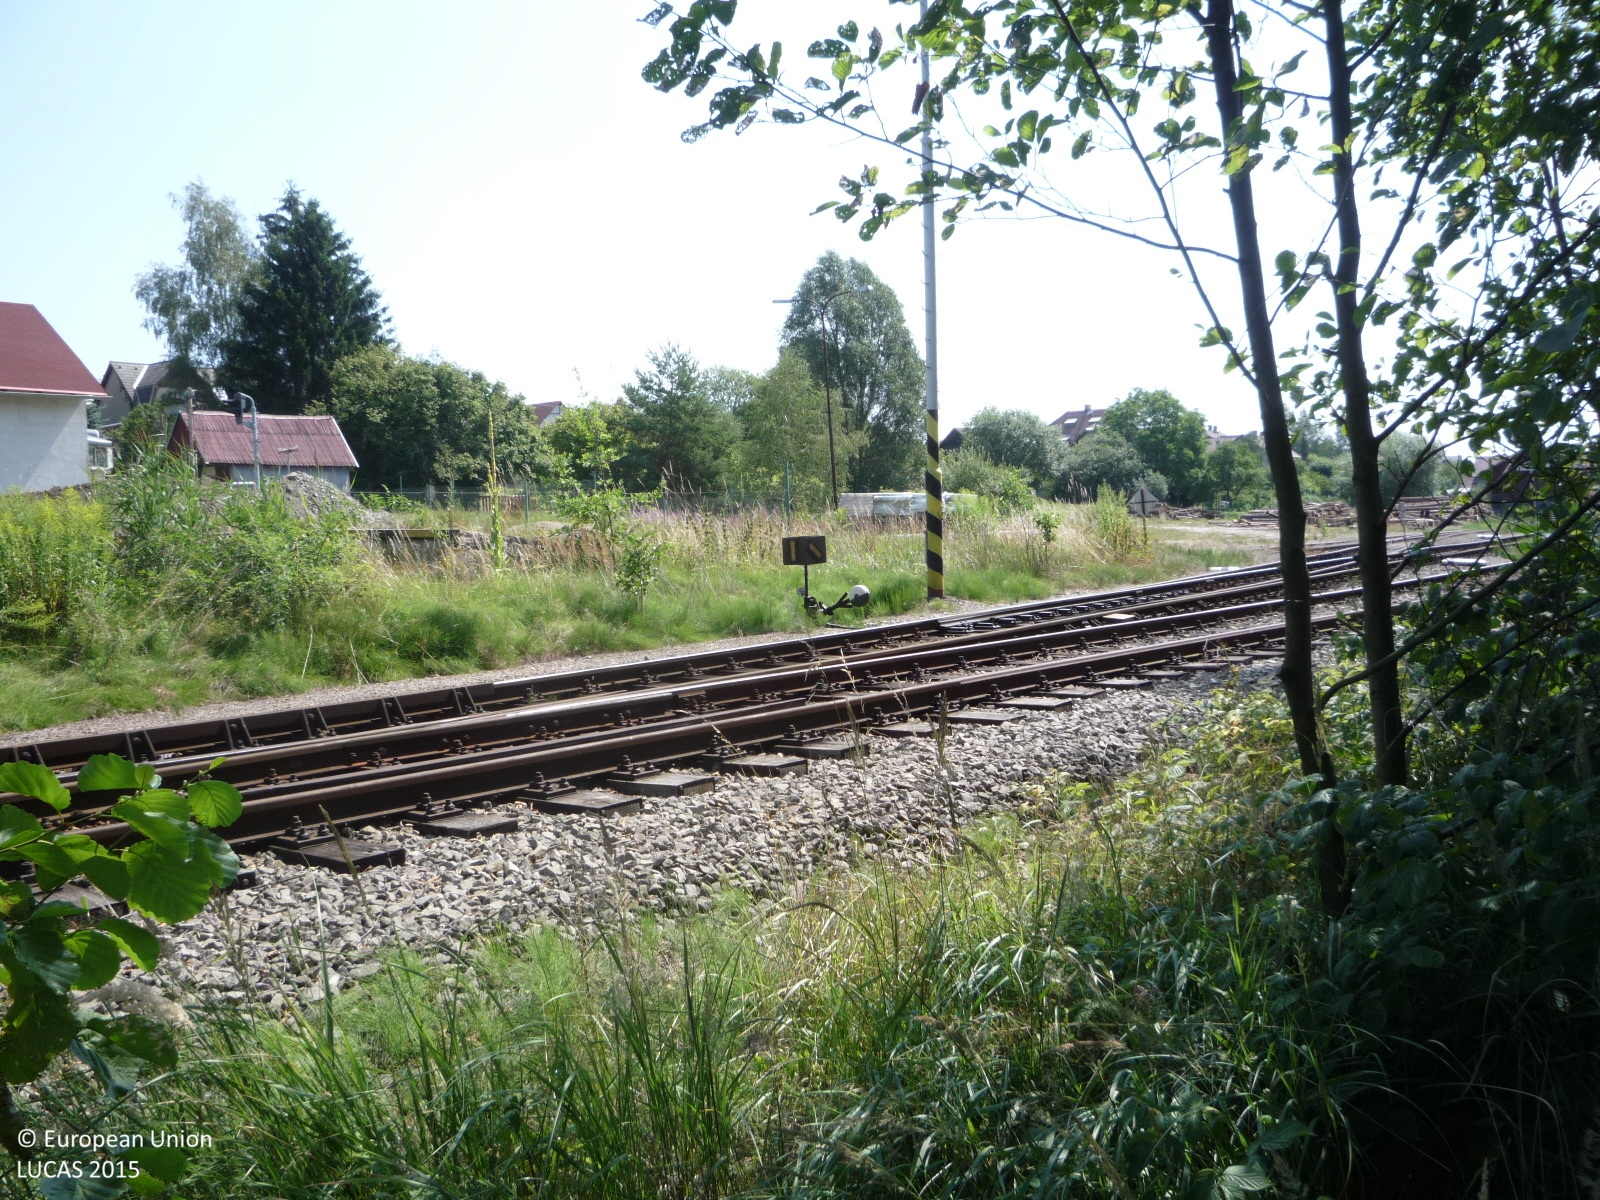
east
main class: Woodland
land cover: Broadleaved woodland
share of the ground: > 75 %
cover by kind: broadleaved forest trees 50 %, herbaceous plants 30 %, shrubs 20 %
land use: Semi-natural and natural areas not in use
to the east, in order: Broadleaved woodland; Artificial constructions in urban areas
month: August
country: CZ
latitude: 50.5516
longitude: 15.2114
